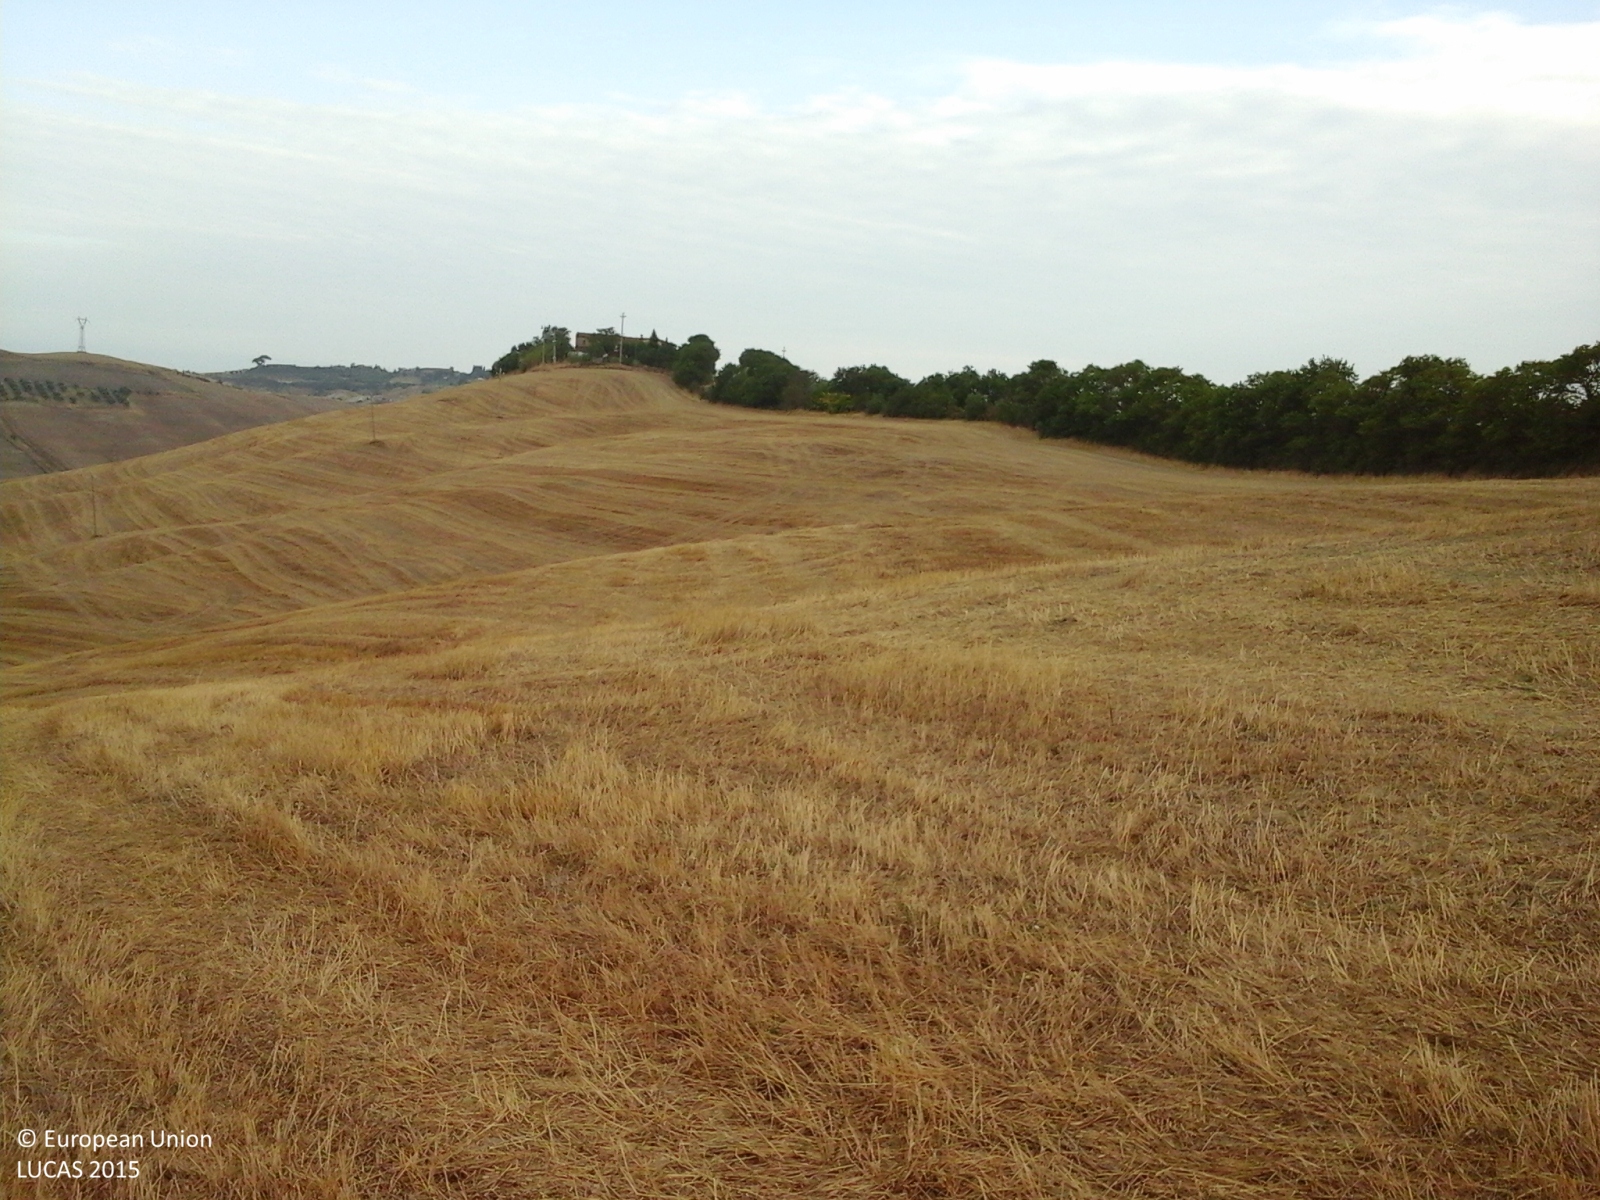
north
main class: Cropland
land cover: Other leguminous and mixtures for fodder
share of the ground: > 75 %
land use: Agriculture (excluding fallow land and kitchen gardens)
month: July
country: IT
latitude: 43.2568
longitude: 11.5107
